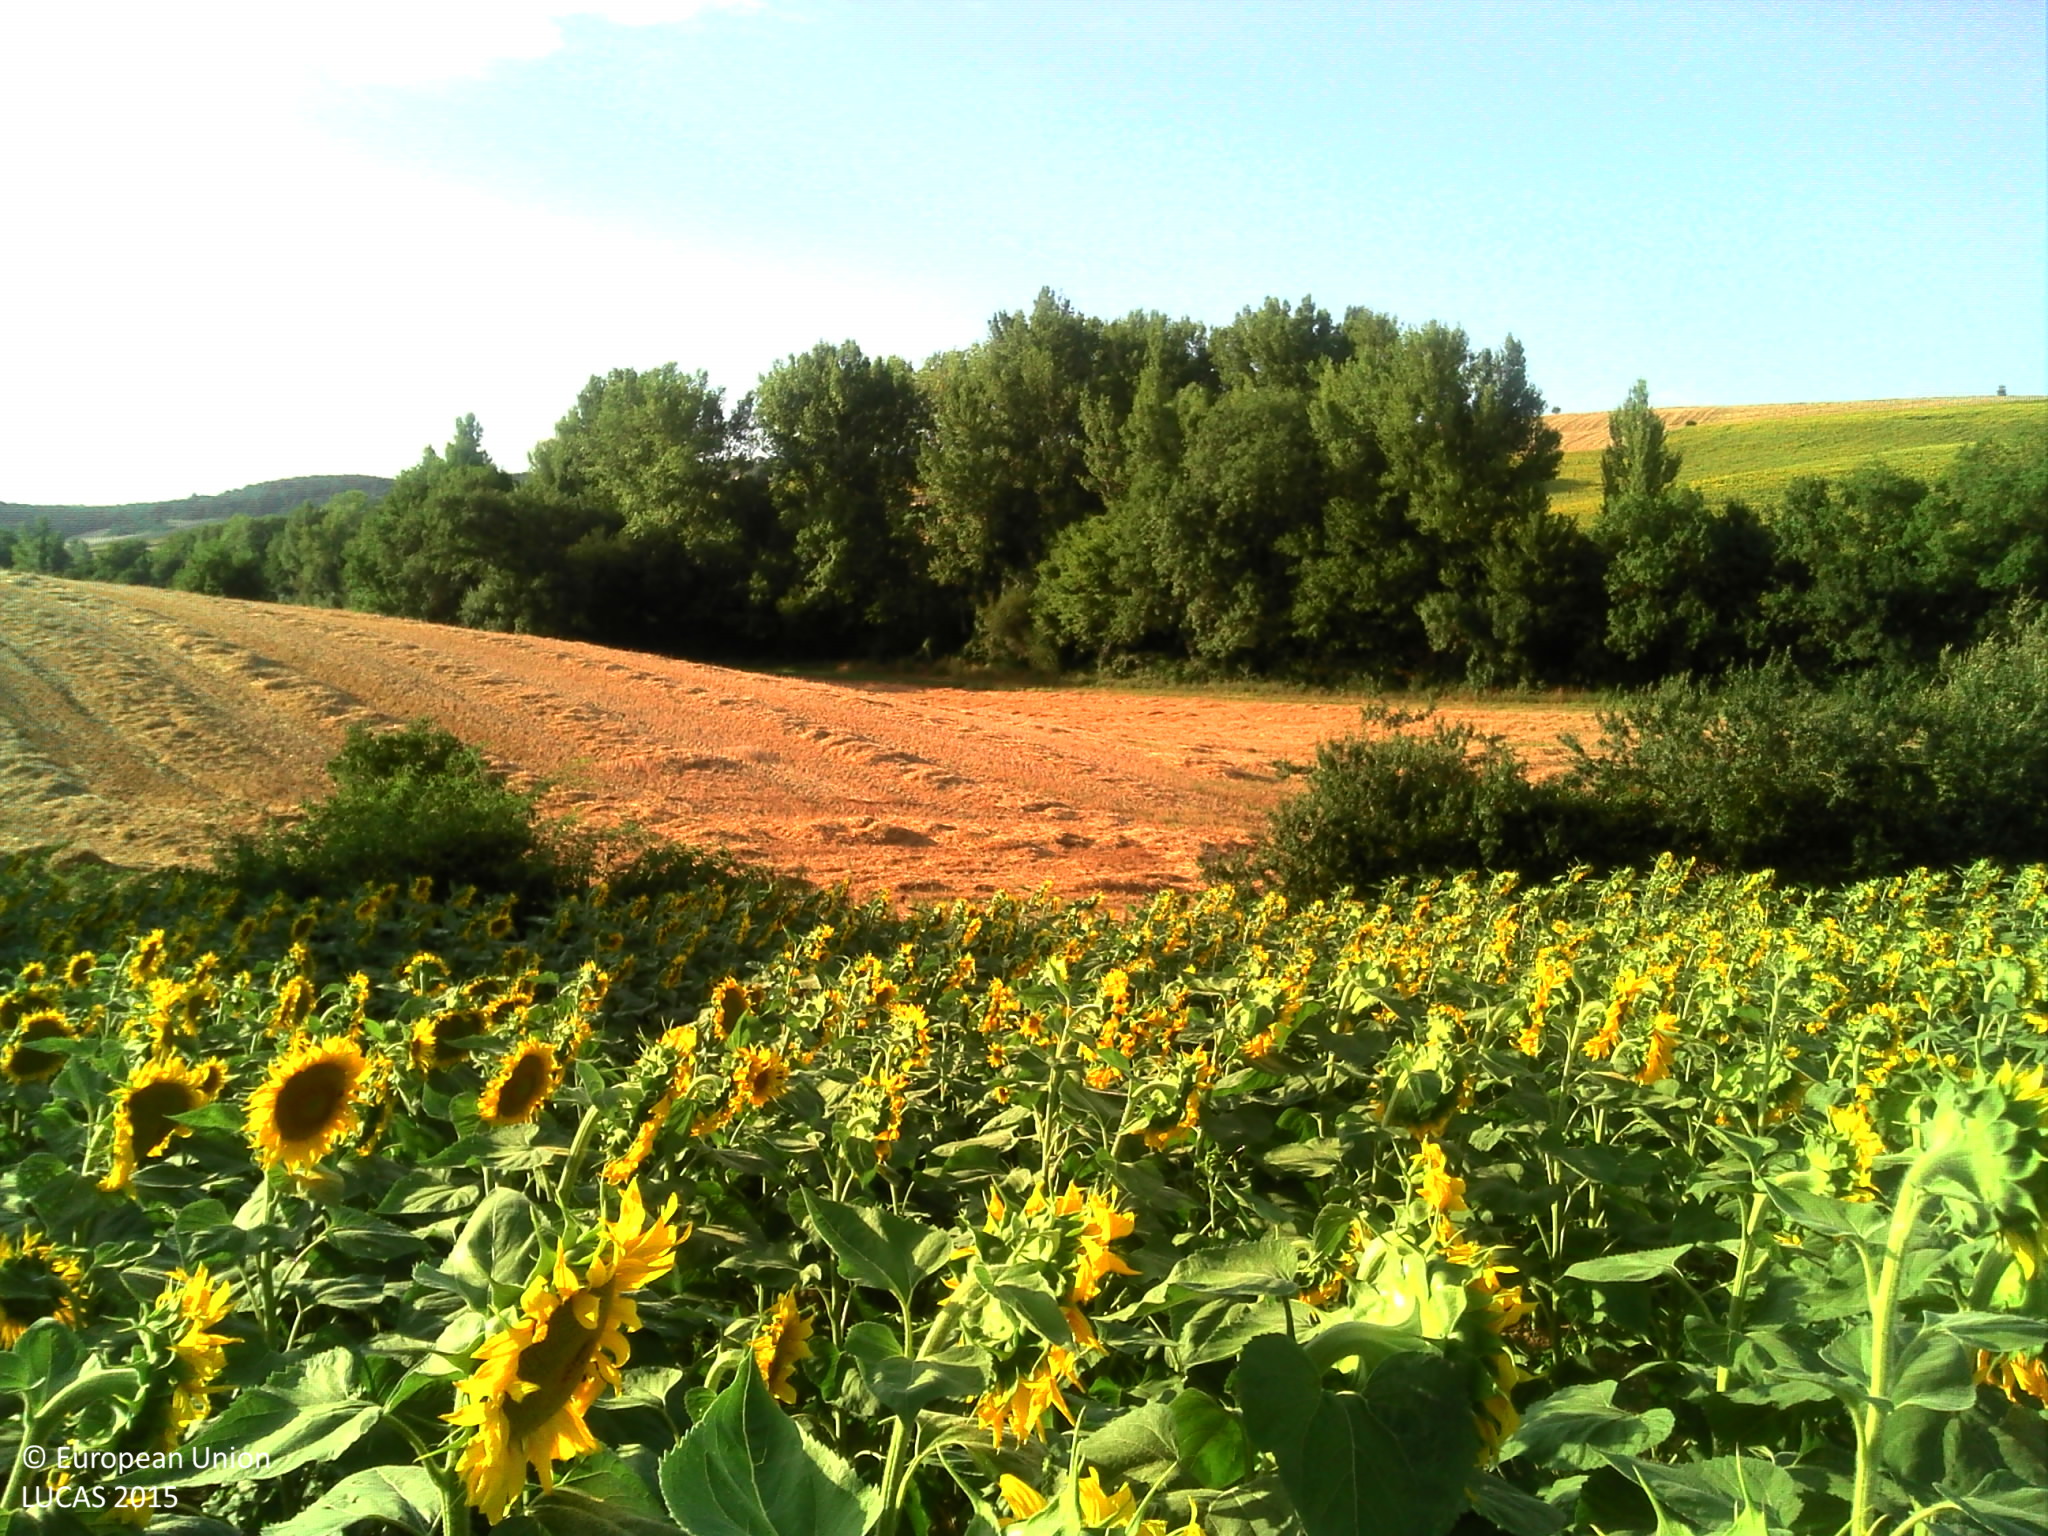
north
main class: Cropland
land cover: Sunflower
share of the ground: > 75 %
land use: Agriculture (excluding fallow land and kitchen gardens)
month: July
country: FR
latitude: 43.8596
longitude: 0.9036
